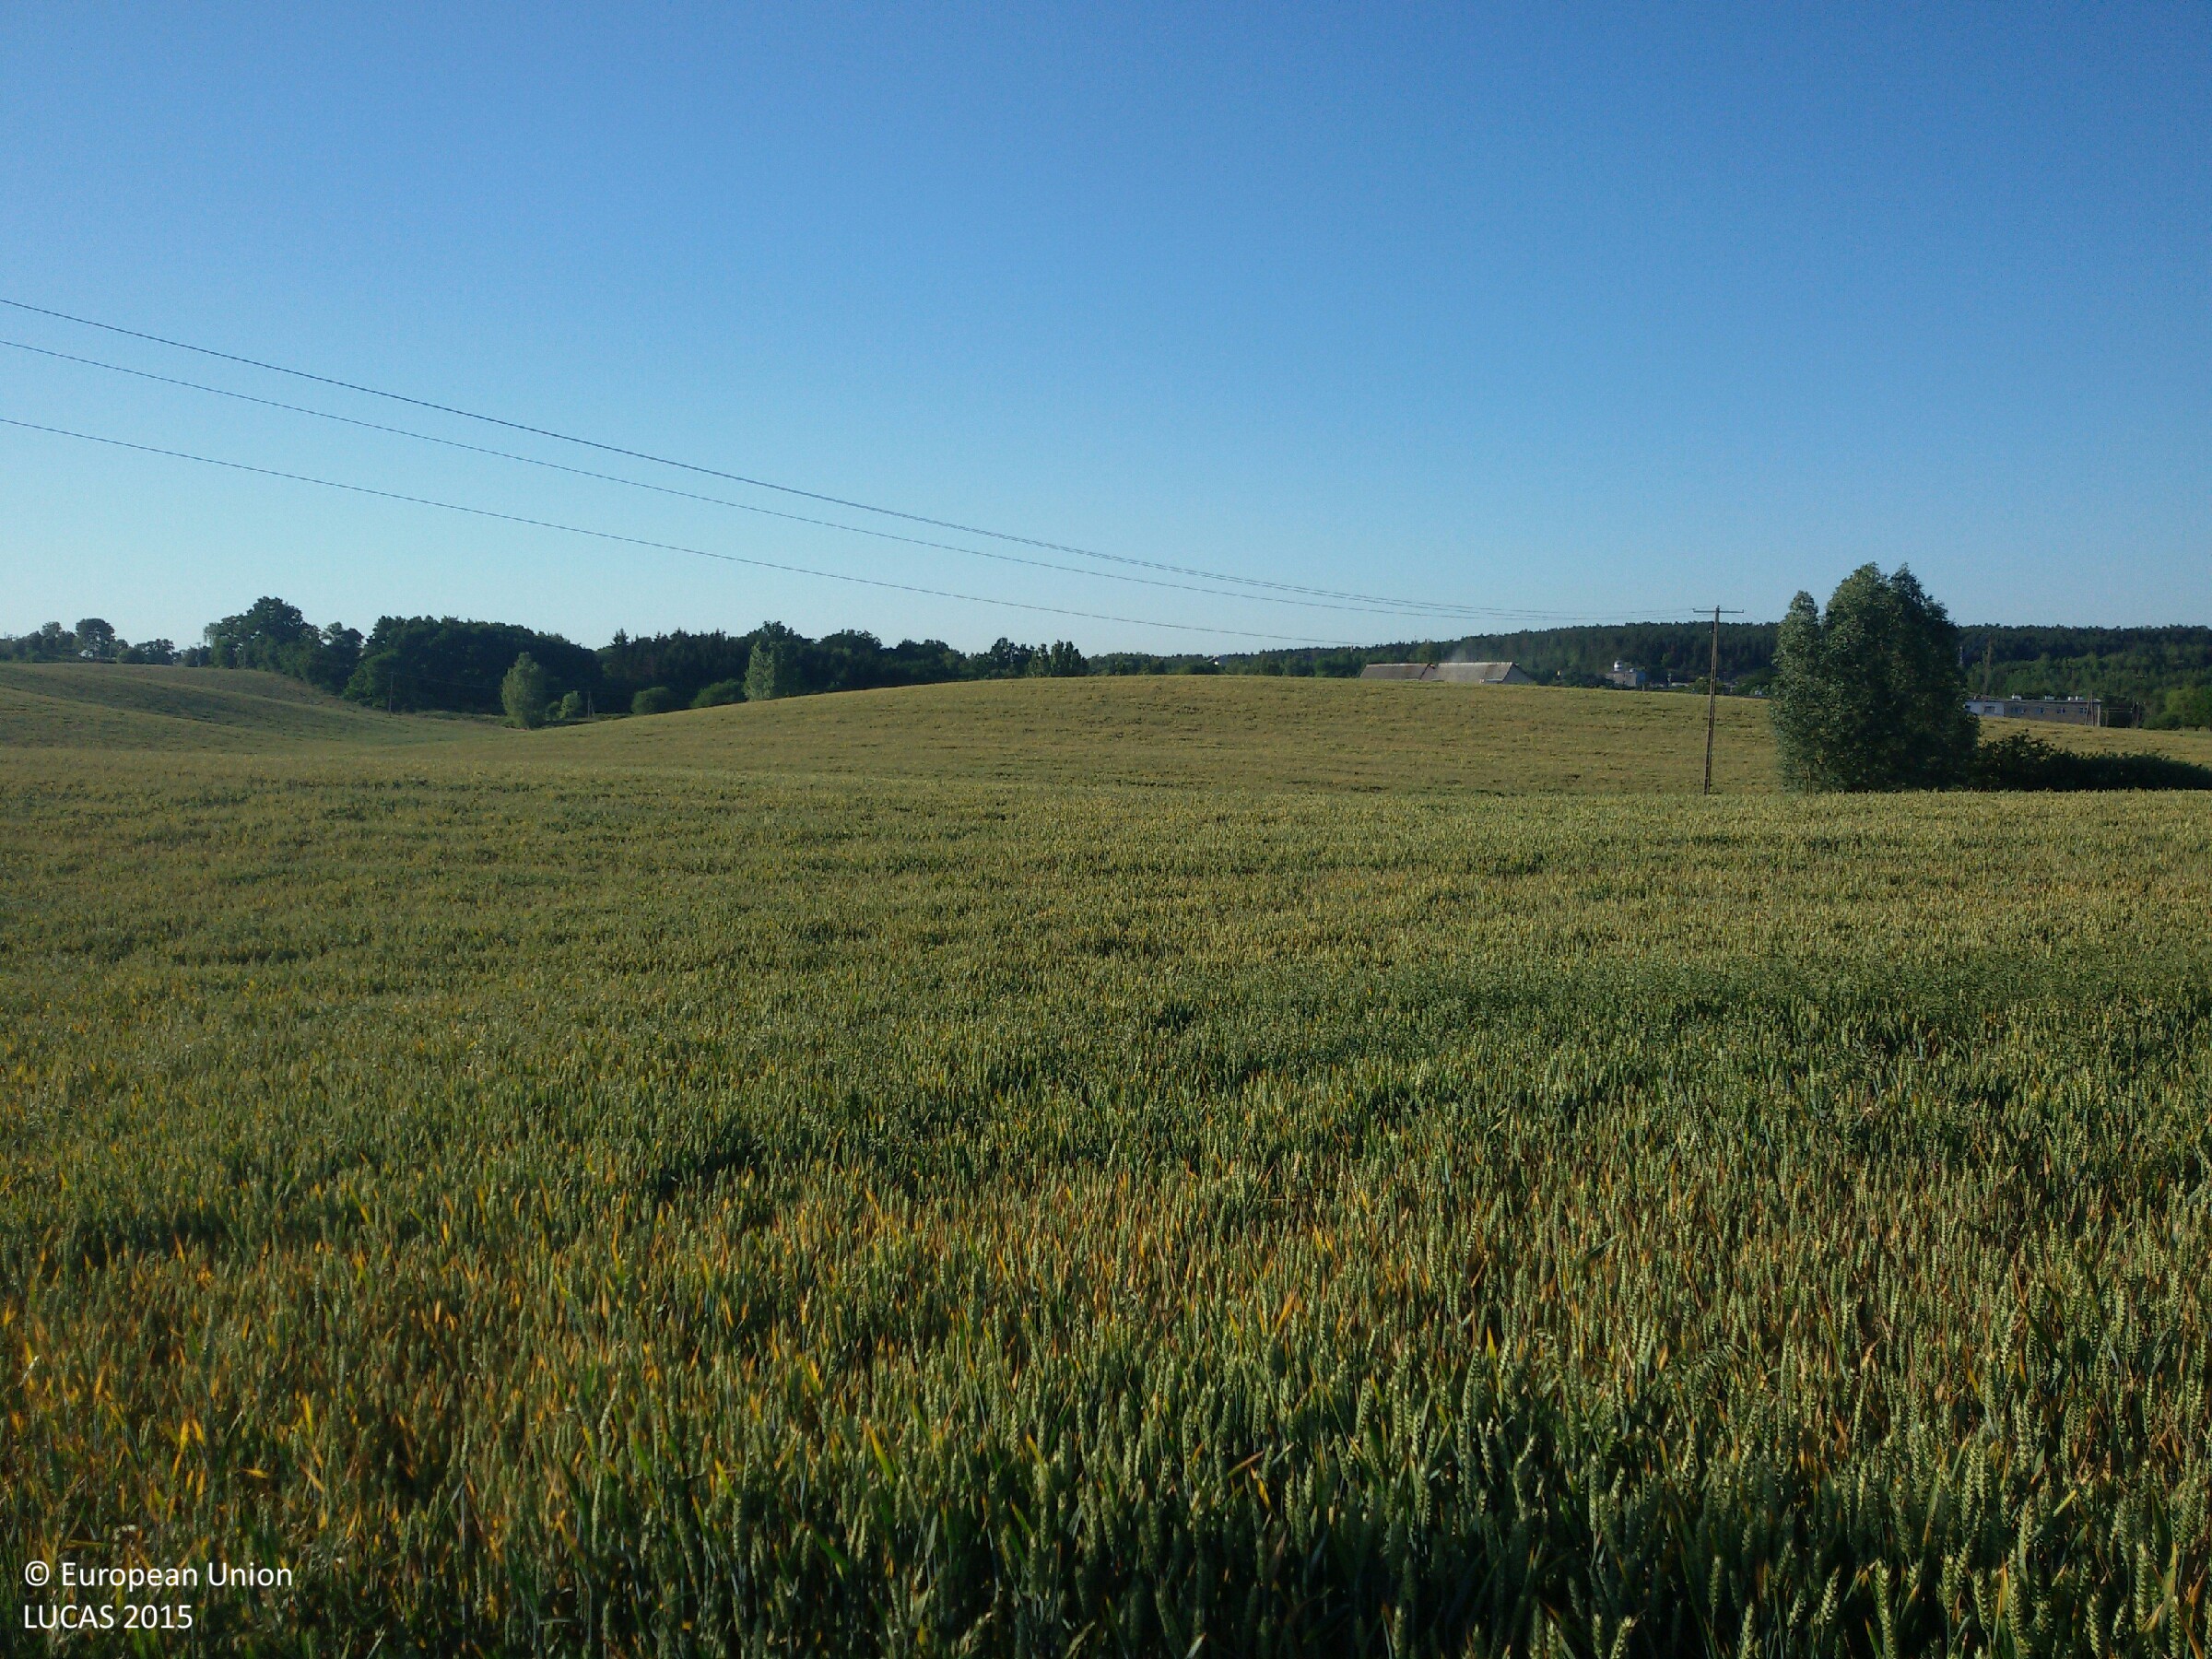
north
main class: Cropland
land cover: Common wheat
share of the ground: > 75 %
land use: Agriculture (excluding fallow land and kitchen gardens)
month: July
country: PL
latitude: 53.8925
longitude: 19.3218
